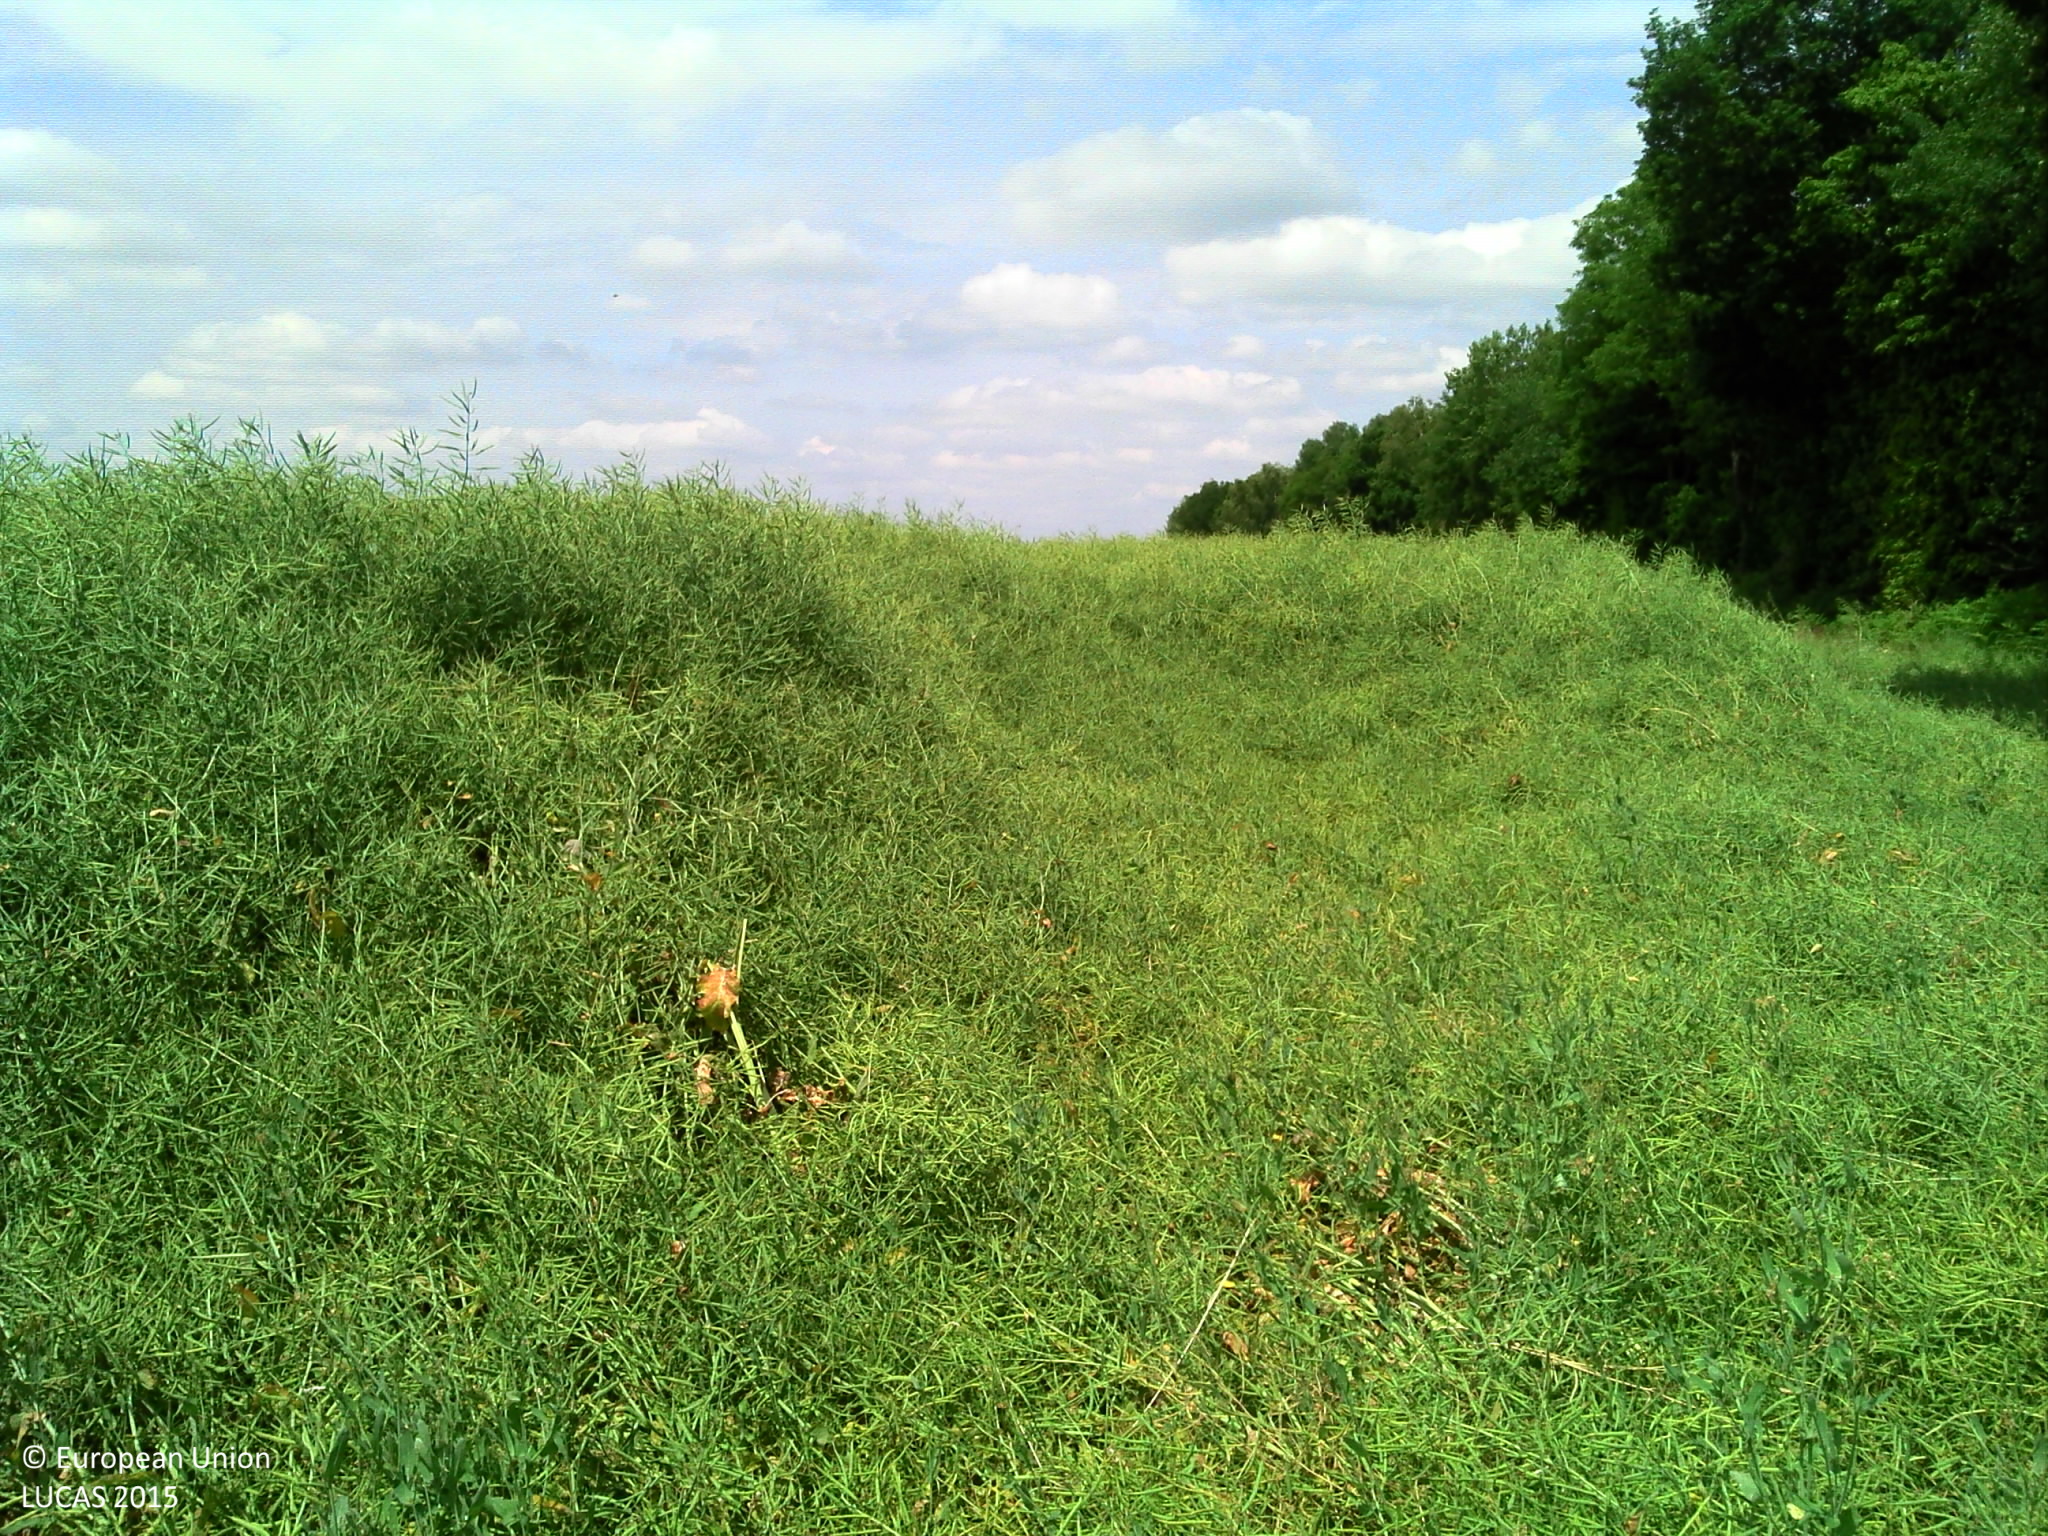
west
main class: Cropland
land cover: Rape and turnip rape
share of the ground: > 75 %
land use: Agriculture (excluding fallow land and kitchen gardens)
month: June
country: FR
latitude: 47.3303
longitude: 5.3032
